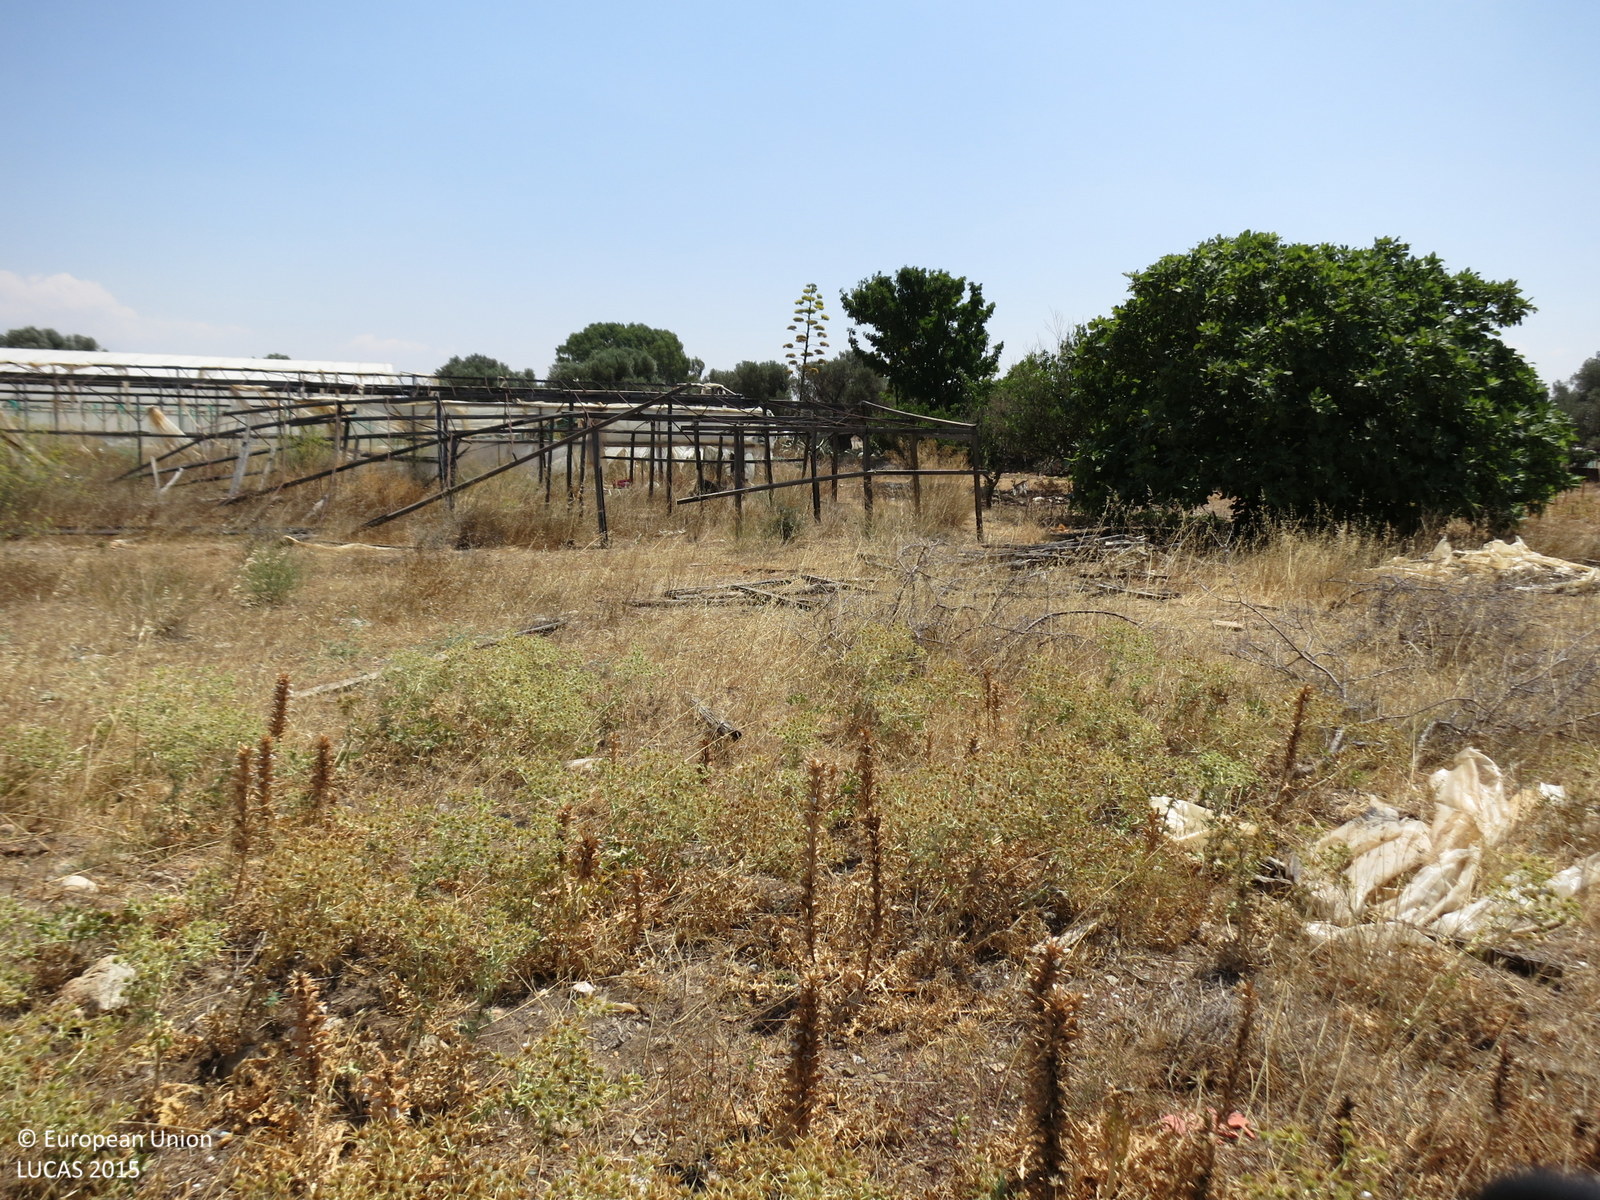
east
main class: Grassland
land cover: Spontaneously vegetated surfaces
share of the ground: > 75 %
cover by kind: herbaceous plants 95 %, shrubs 5 %
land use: Fallow land
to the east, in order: Spontaneously vegetated surfaces; Artificial constructions in urban areas; Olive groves; Tracks; Olive groves; Fences; Spontaneously vegetated surfaces; Tracks; Spontaneously vegetated surfaces; Fences; Grass margins; Paved roads, cycling and walking lanes; Olive groves
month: July
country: GR
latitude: 35.0790
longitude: 24.7571
